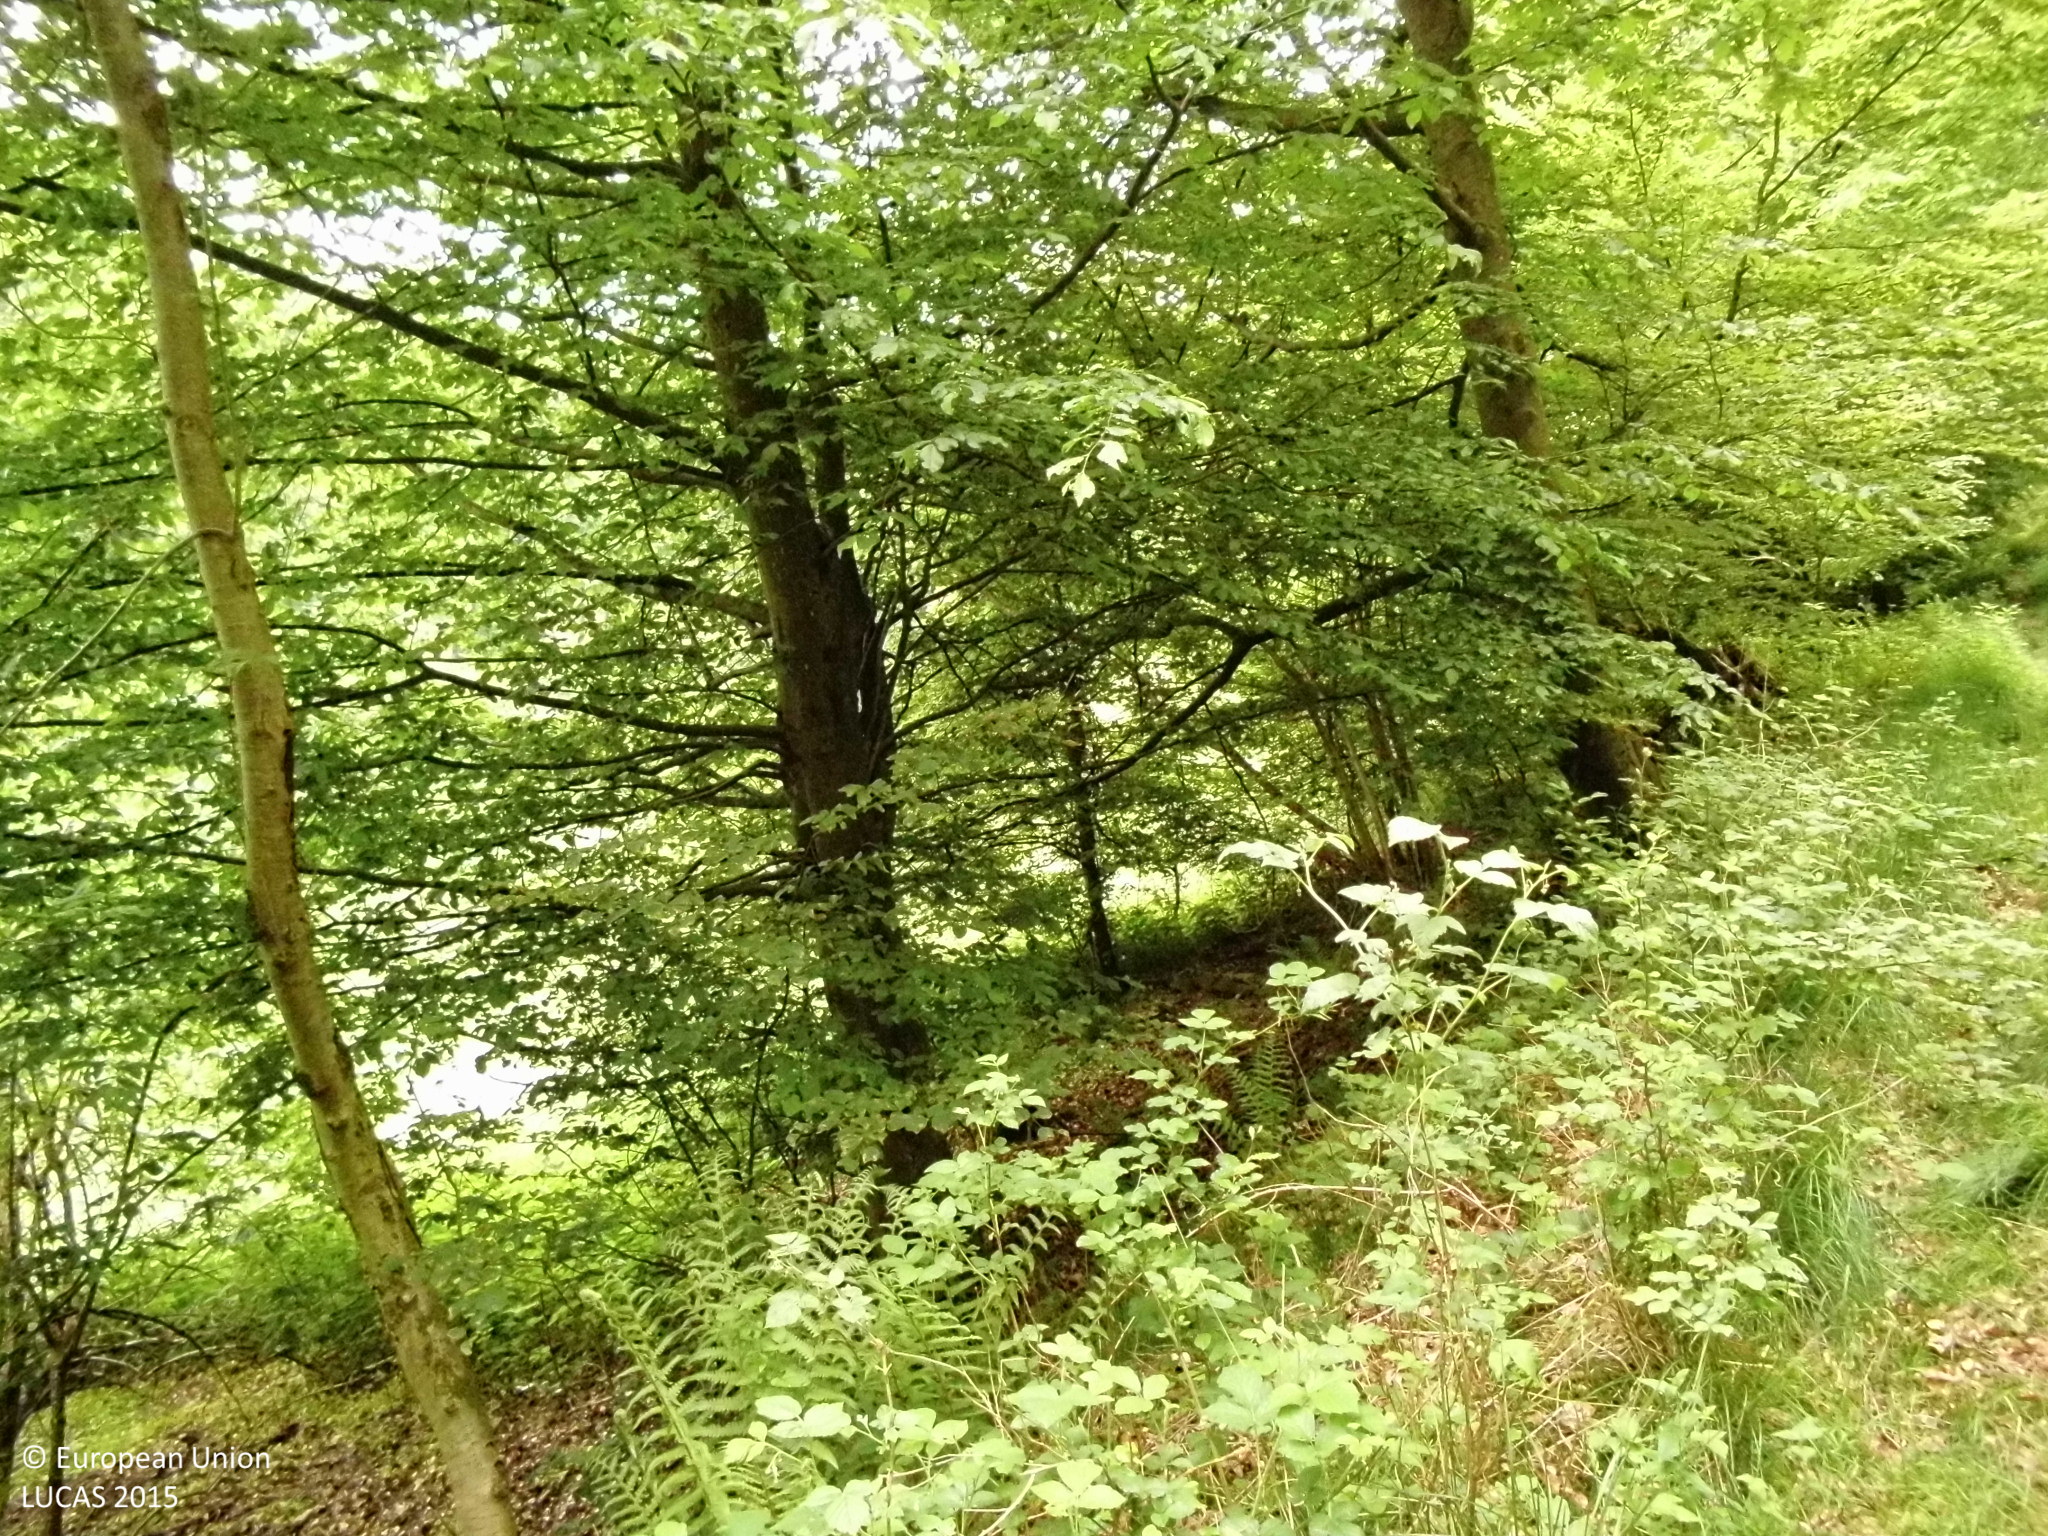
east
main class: Woodland
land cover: Broadleaved woodland
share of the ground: 50 - 75 %
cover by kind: broadleaved forest trees 70 %, shrubs 15 %, herbaceous plants 15 %
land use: Forestry
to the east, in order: Tracks; Broadleaved woodland; Grassland without tree/shrub cover; Electric lines; Grassland without tree/shrub cover; Rivers and streams; Grassland without tree/shrub cover; Broadleaved woodland; Tracks; Spruce dominated mixed woodland; Fences; Grassland without tree/shrub cover; Fences; Spruce dominated coniferous woodland; Tracks; Spruce dominated coniferous woodland; Broadleaved woodland
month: May
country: DE
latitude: 50.5527
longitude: 7.5021
